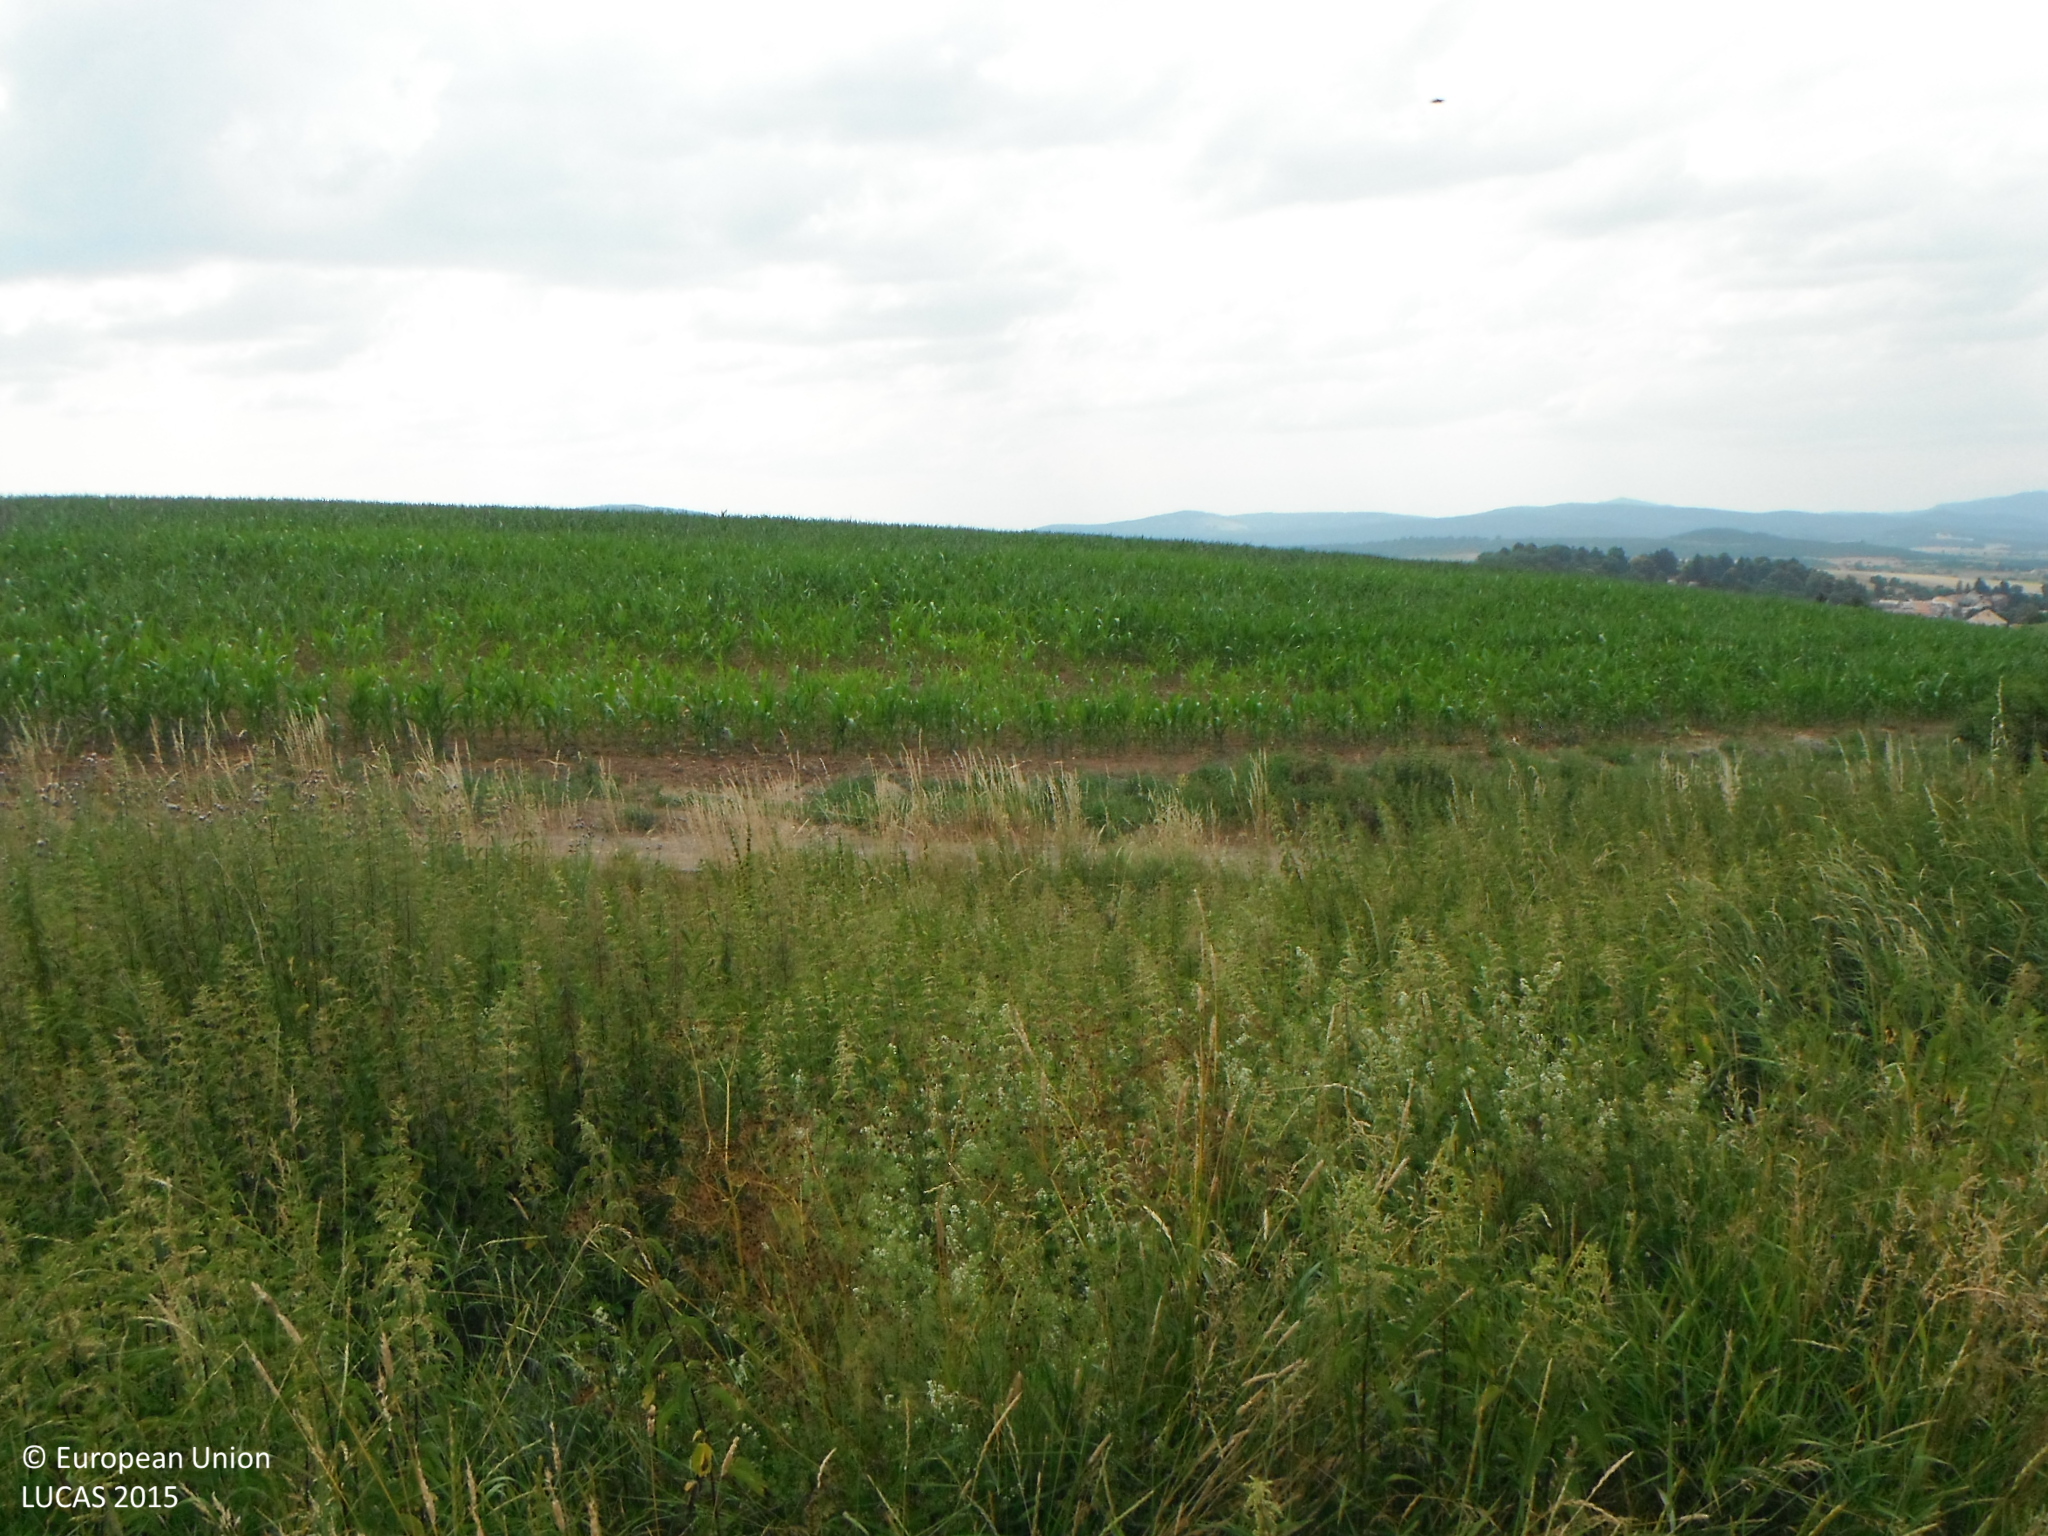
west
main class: Cropland
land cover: Common wheat
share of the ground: > 75 %
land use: Agriculture (excluding fallow land and kitchen gardens)
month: July
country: SK
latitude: 48.4201
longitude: 19.1697
